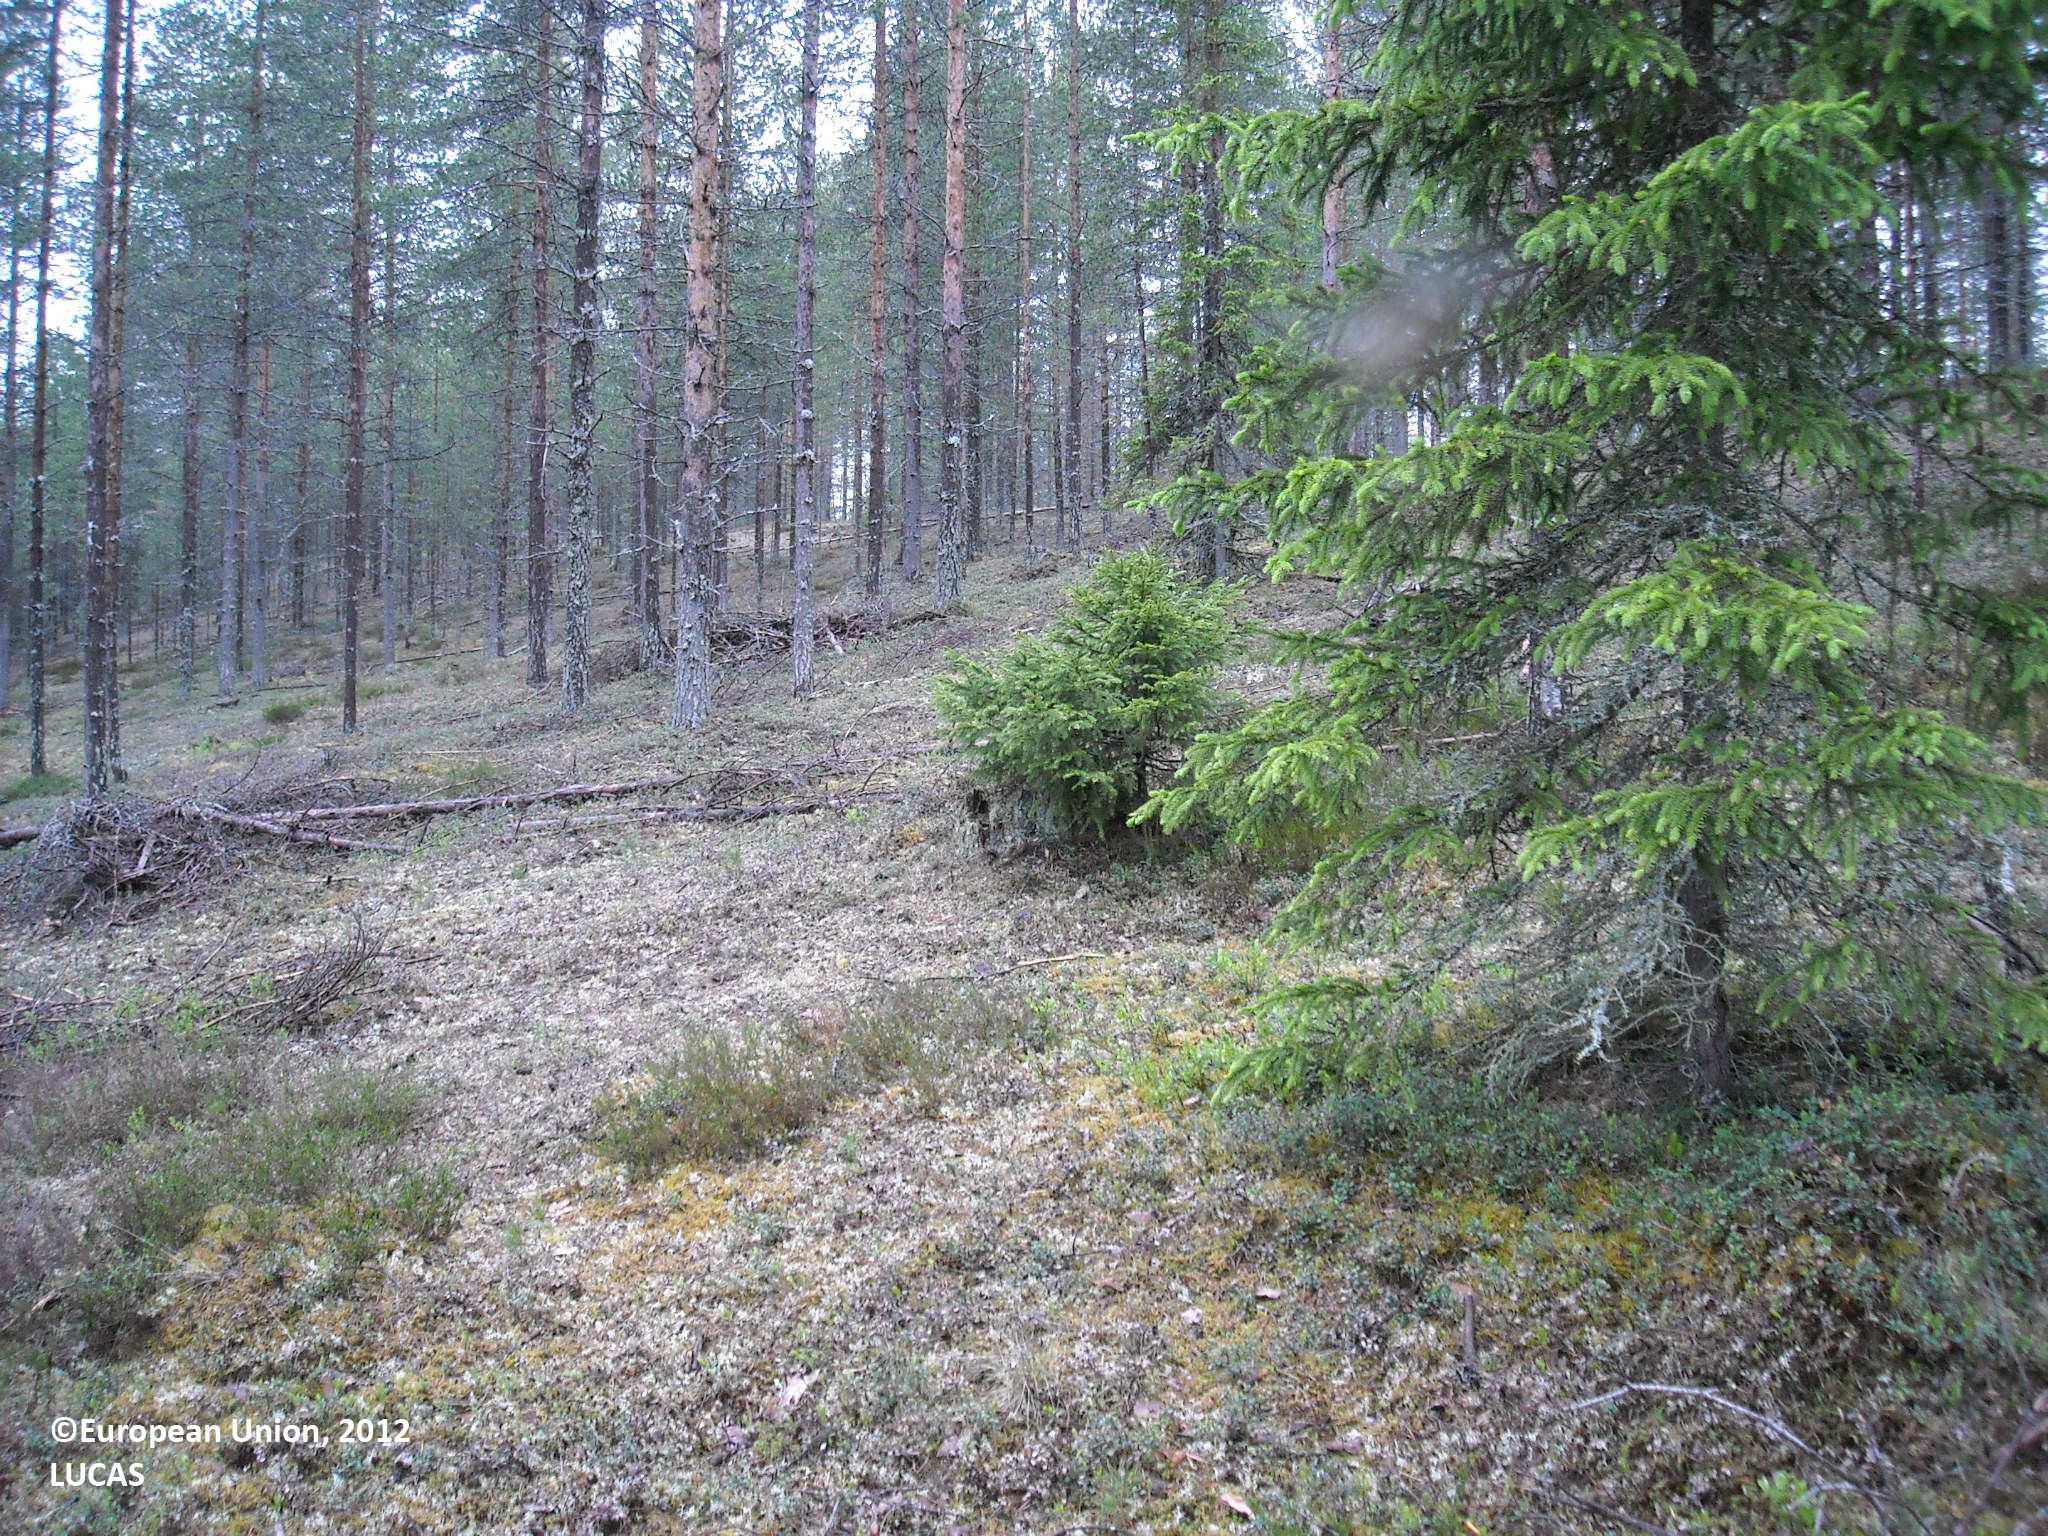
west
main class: Woodland
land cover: Pine dominated coniferous woodland
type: boreal forest
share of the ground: 50 - 75 %
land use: Forestry
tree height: > 5 m
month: June
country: FI
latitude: 65.5075
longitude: 27.9338
